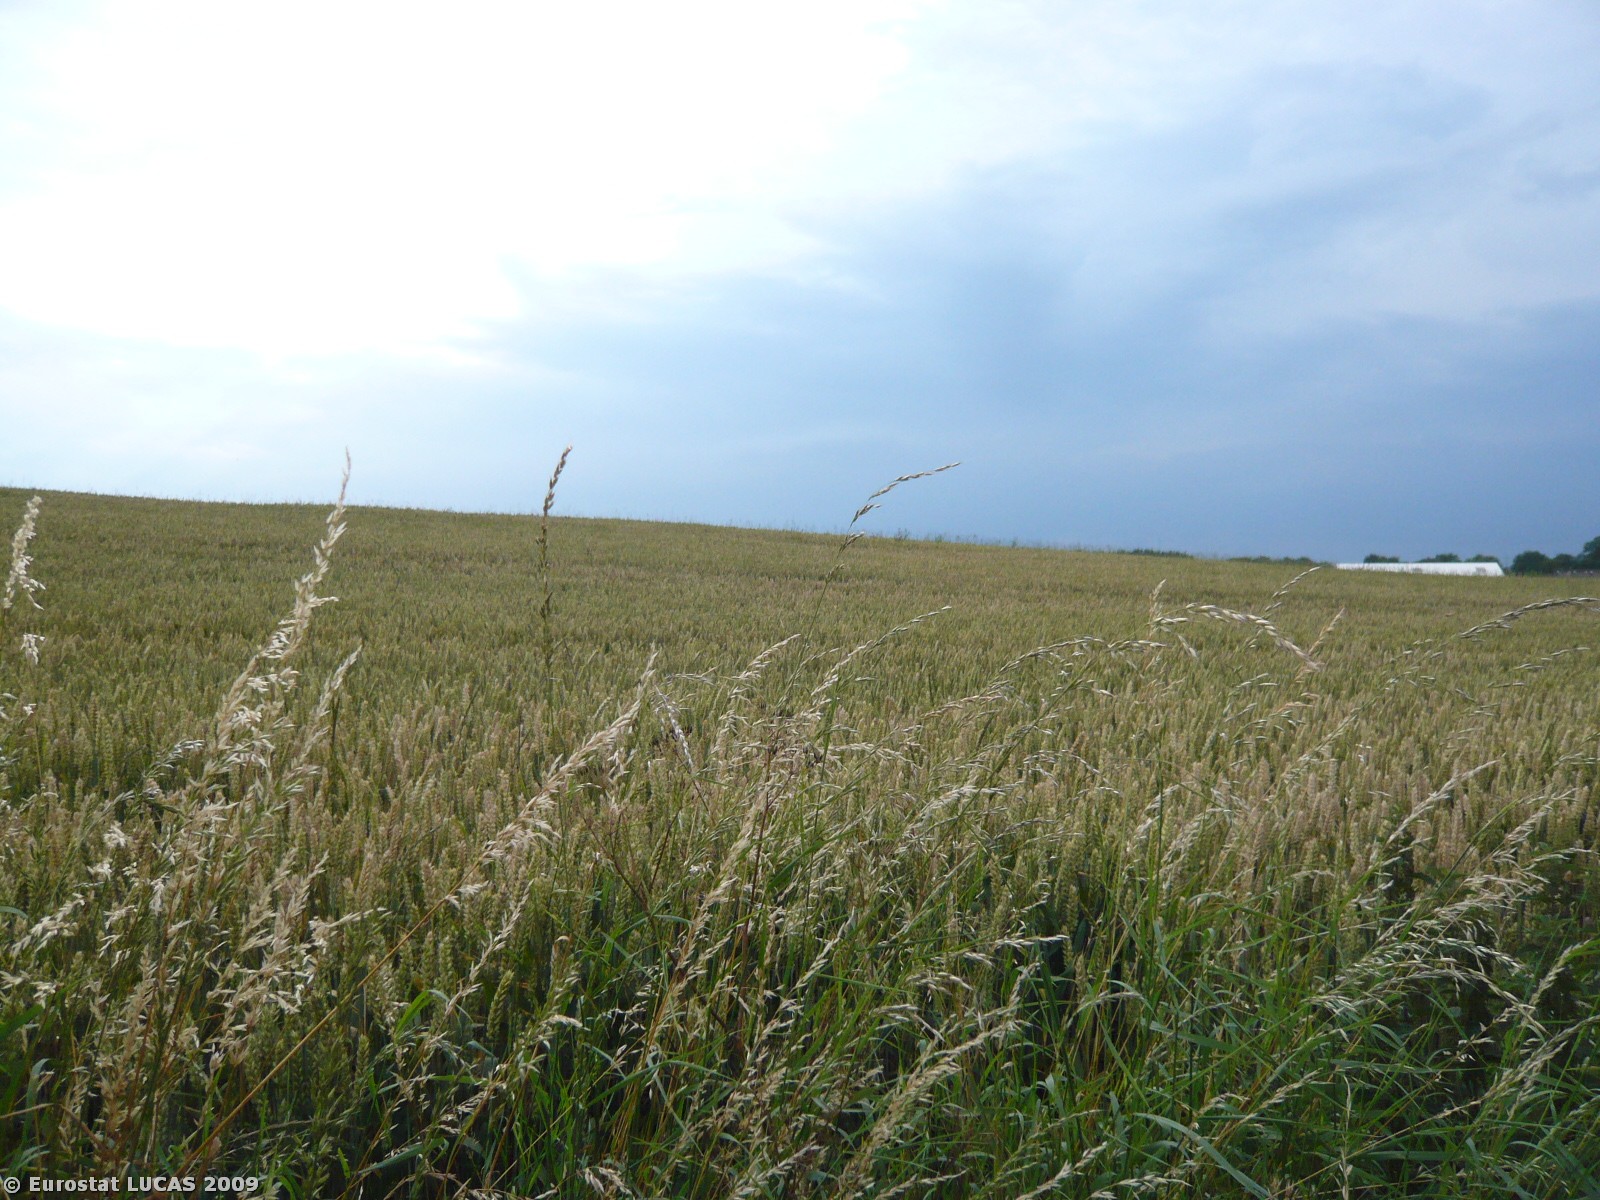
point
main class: Cropland
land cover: Common wheat
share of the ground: > 75 %
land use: Agriculture (excluding fallow land and kitchen gardens)
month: July
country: DK
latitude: 55.6945
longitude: 11.4146
